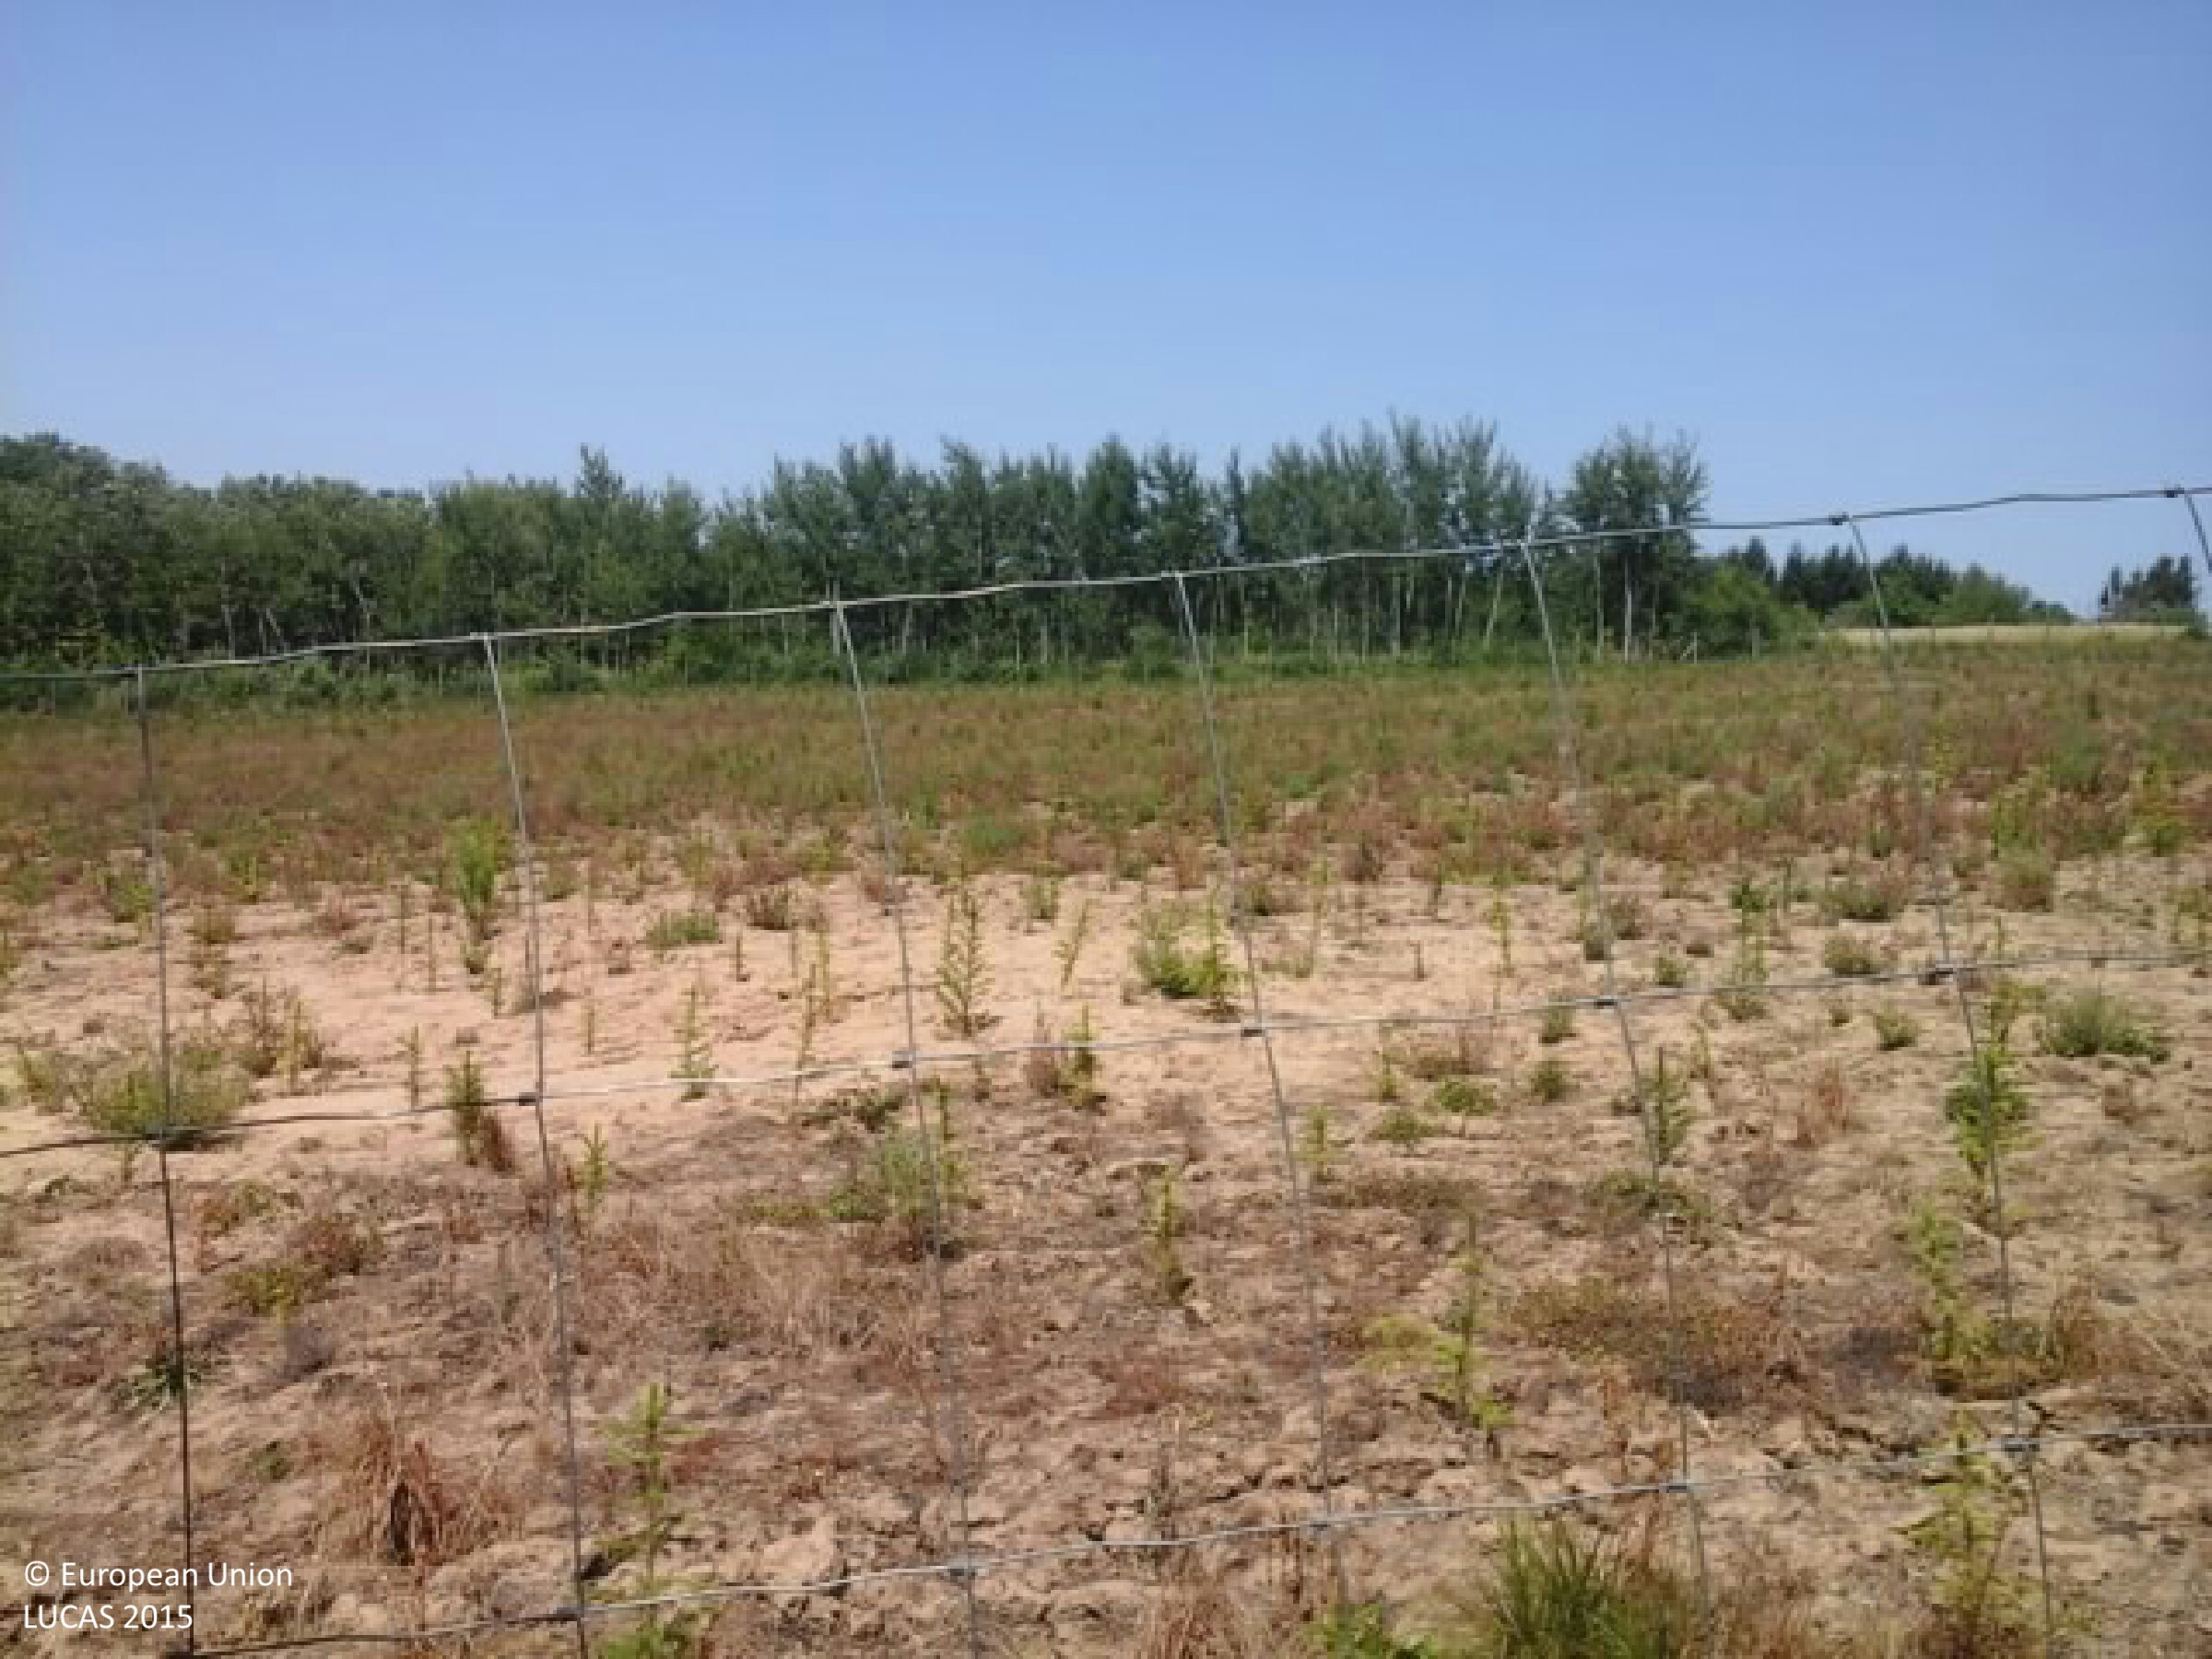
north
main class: Cropland
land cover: Nurseries
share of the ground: 25 - 50 %
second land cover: Spontaneously vegetated surfaces
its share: 50 - 75 %
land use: Forestry
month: July
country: HU
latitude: 46.2795
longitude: 17.0754
